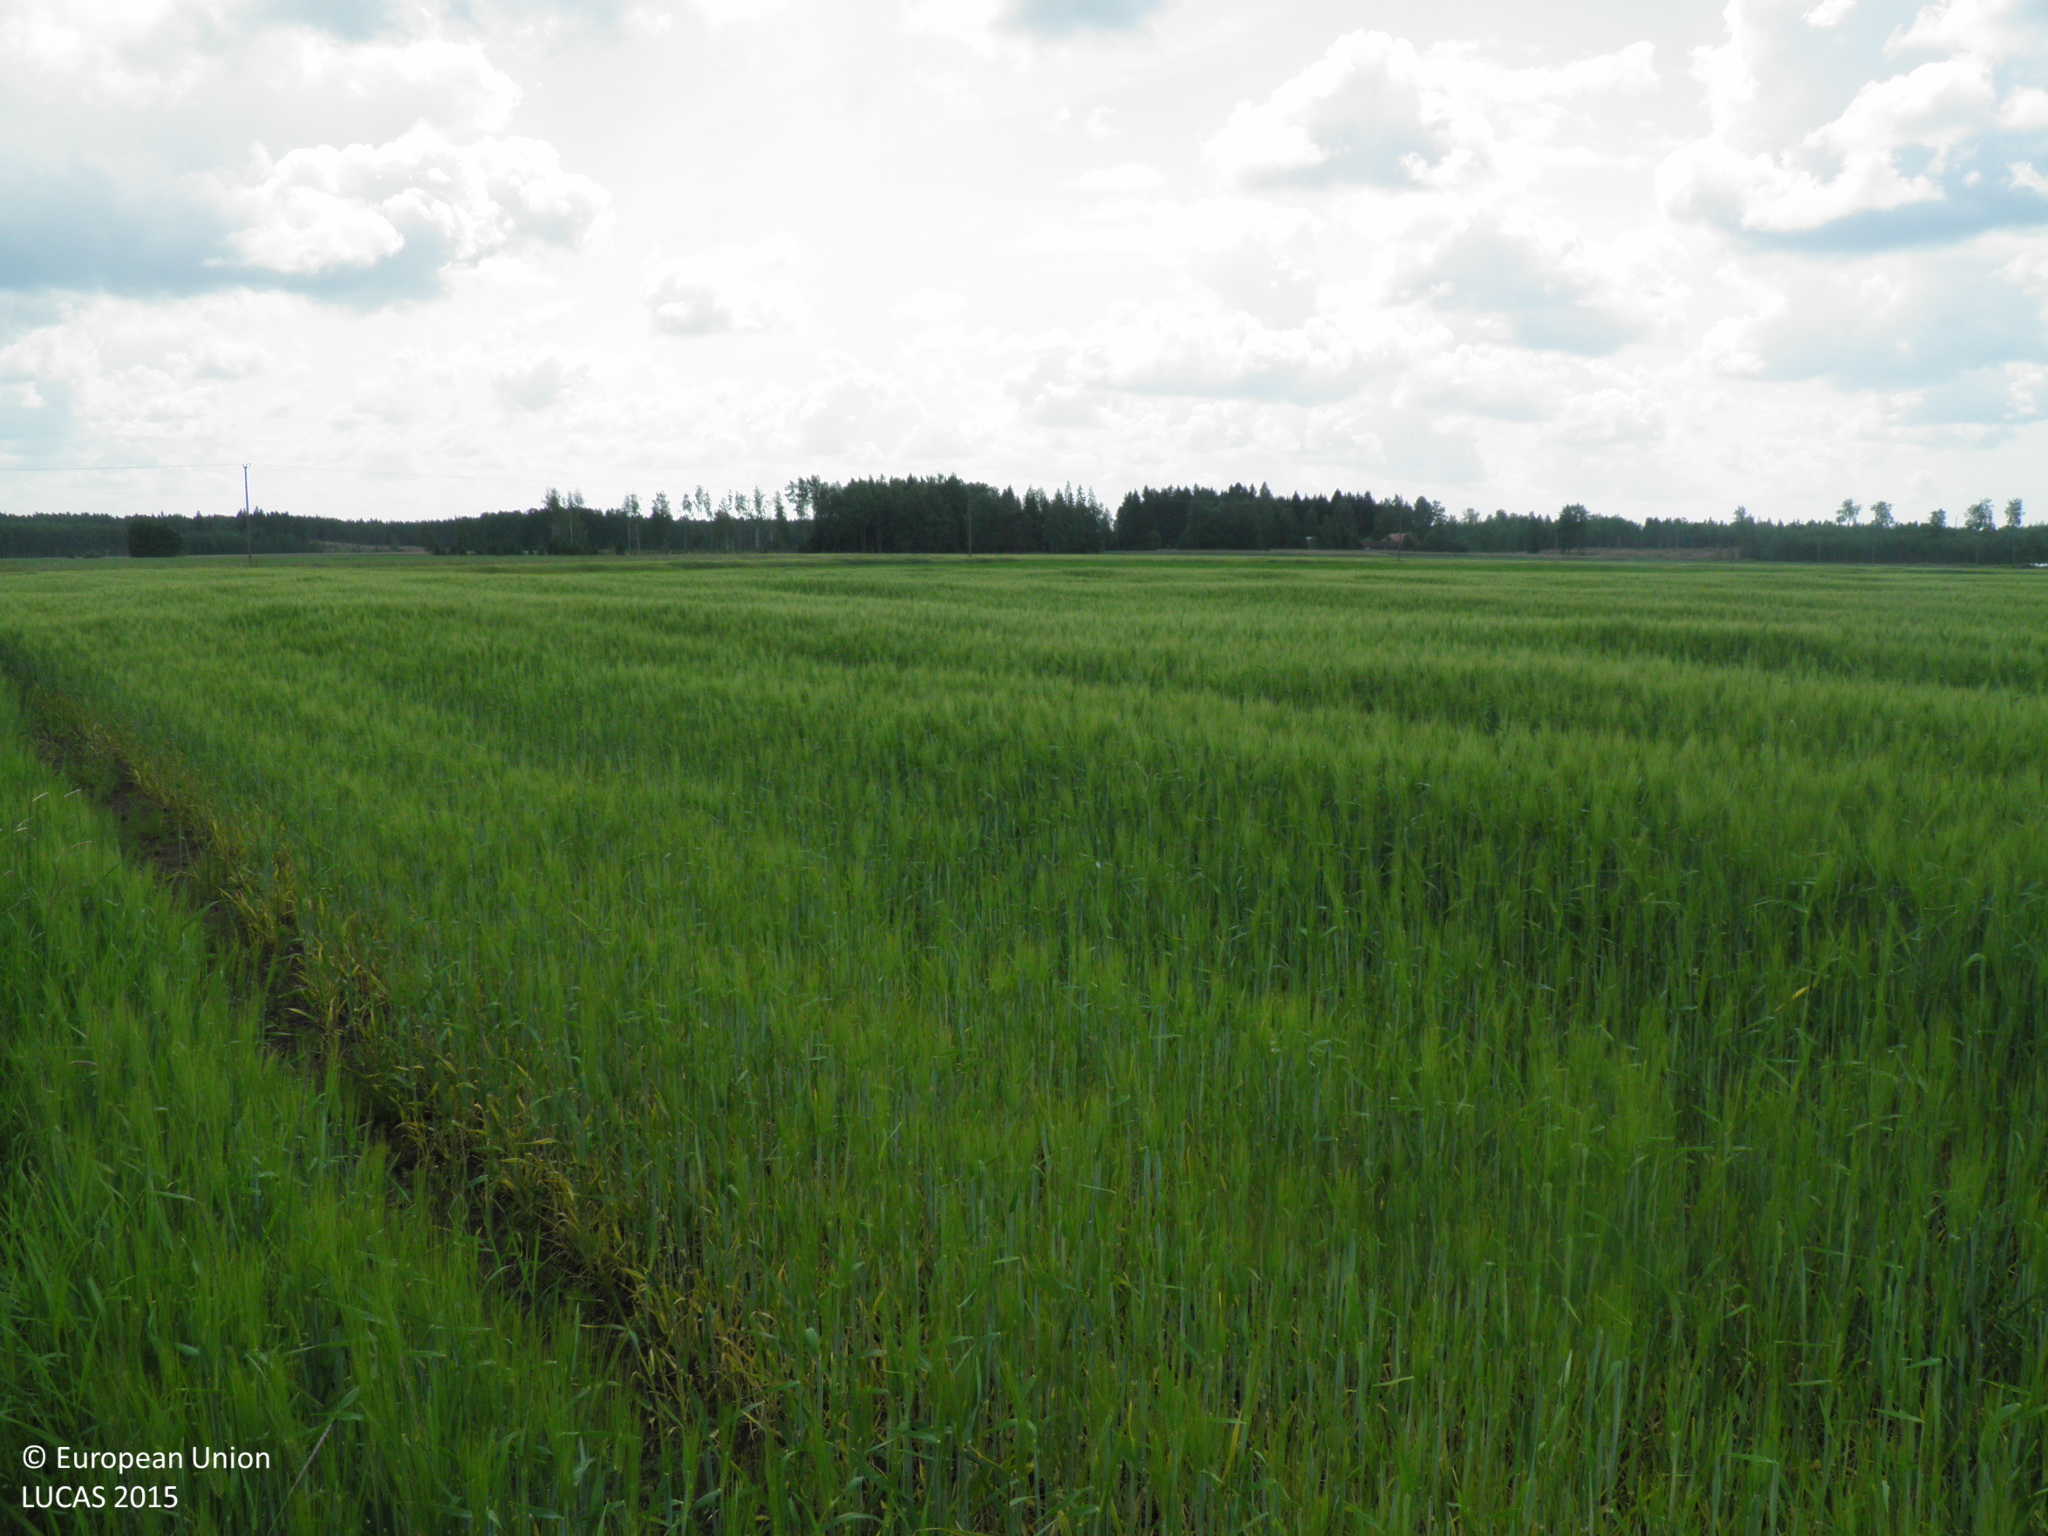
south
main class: Cropland
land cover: Barley
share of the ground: > 75 %
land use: Agriculture (excluding fallow land and kitchen gardens)
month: July
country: FI
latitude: 60.6553
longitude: 22.3787
